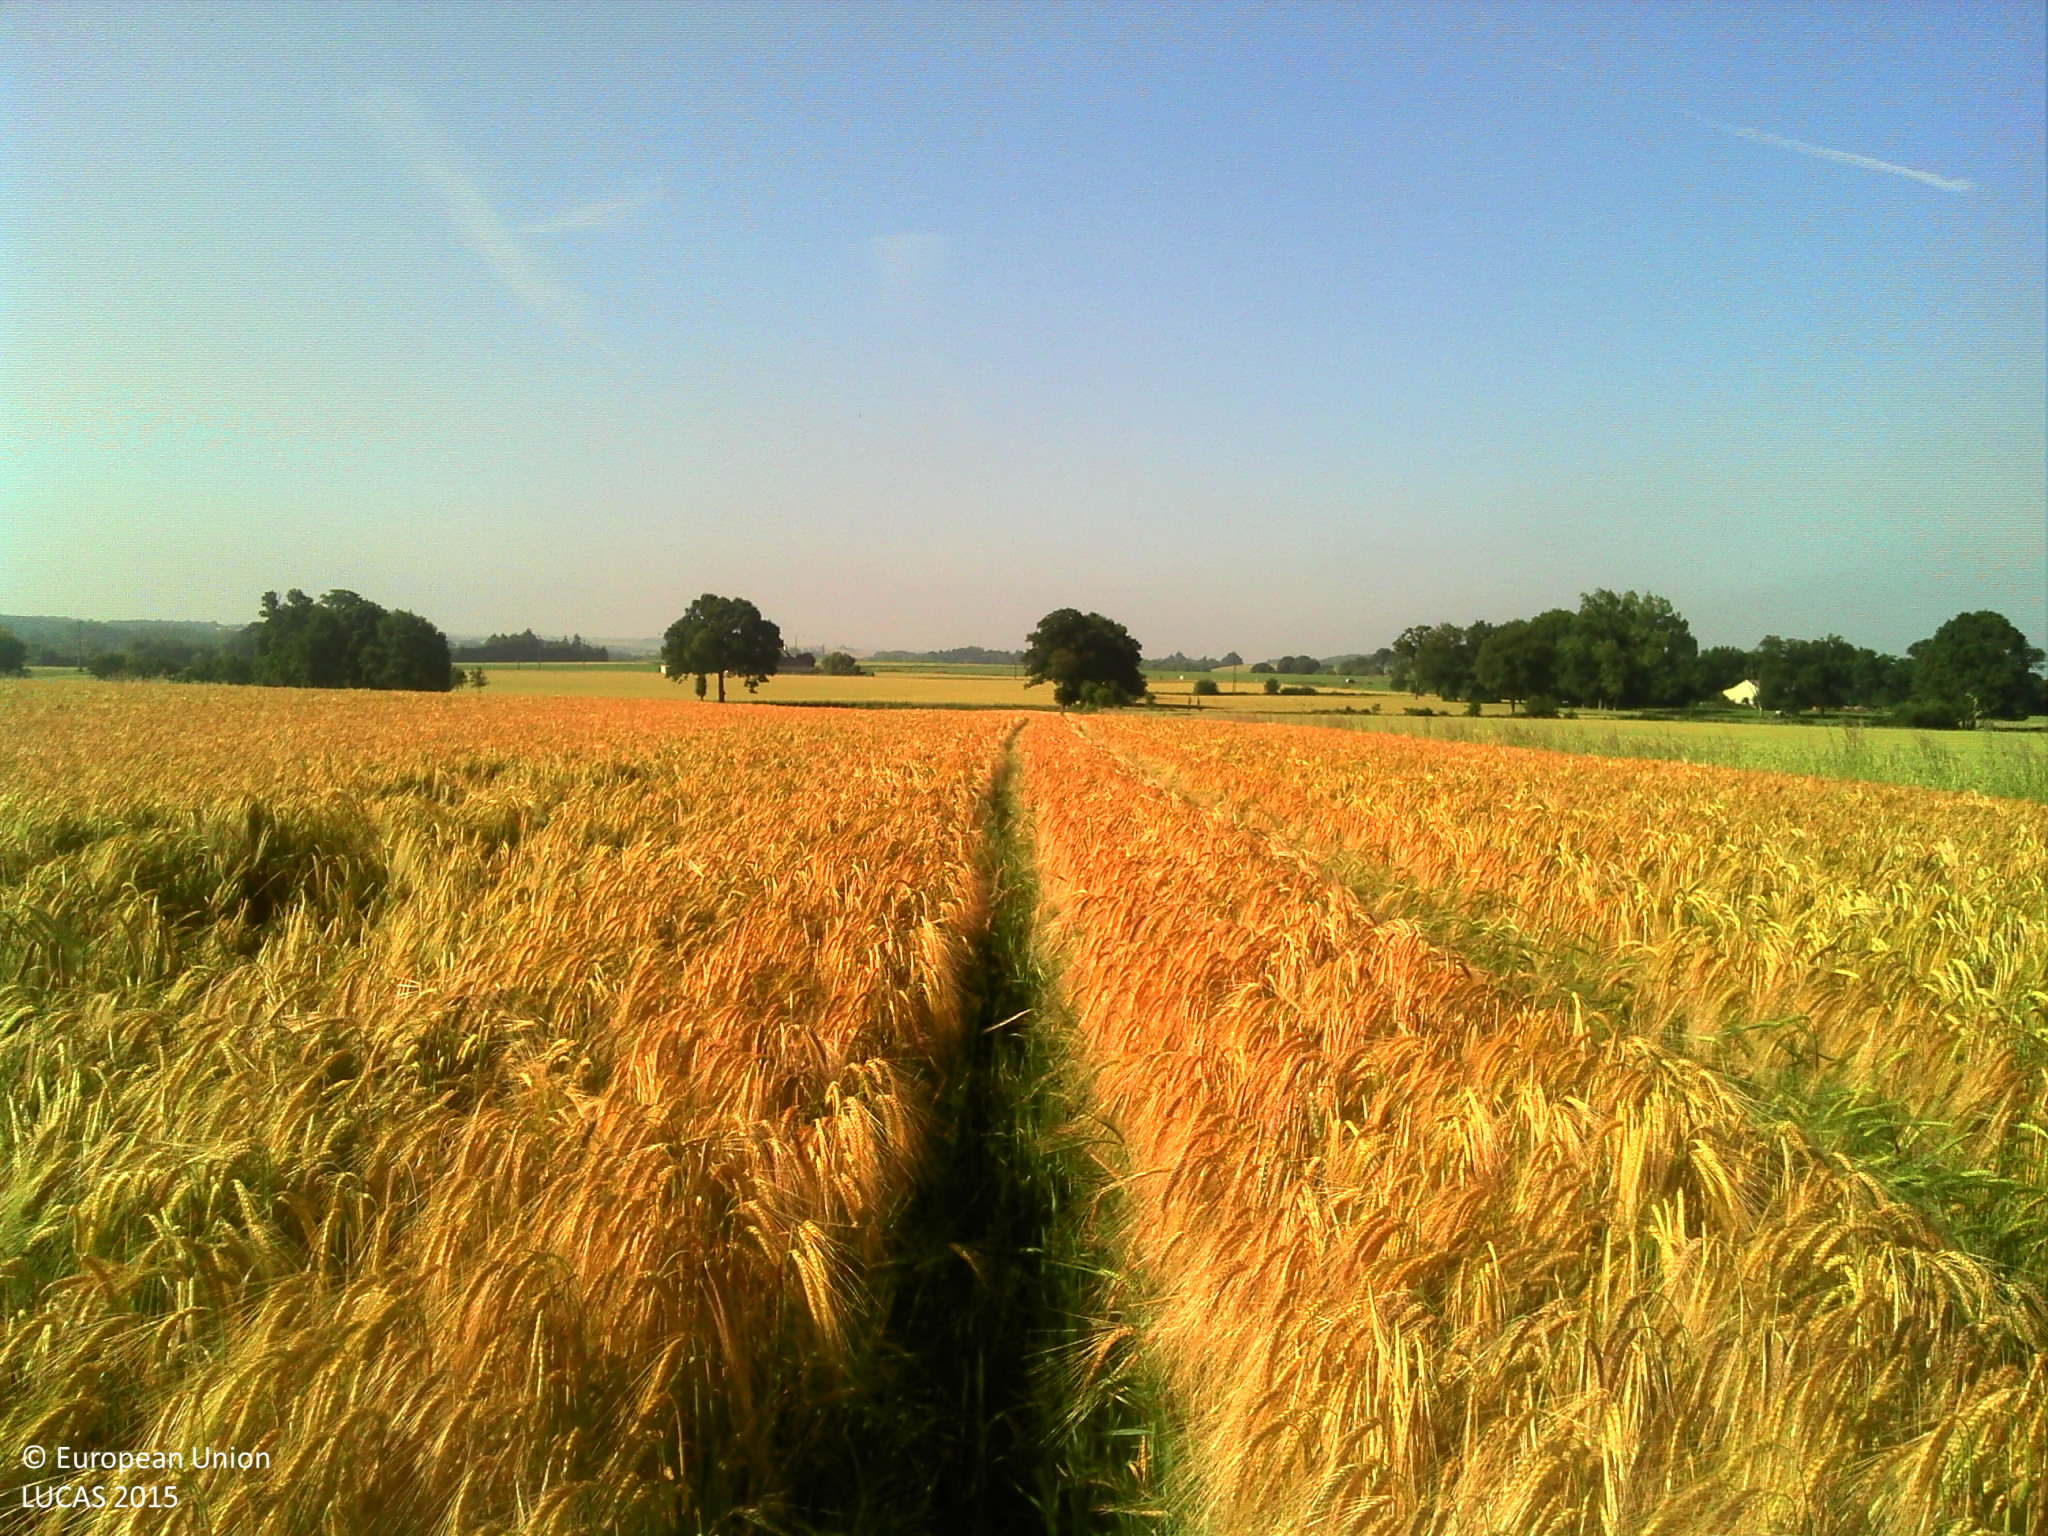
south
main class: Cropland
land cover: Barley
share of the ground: > 75 %
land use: Agriculture (excluding fallow land and kitchen gardens)
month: June
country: FR
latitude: 48.0063
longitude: -1.4515
